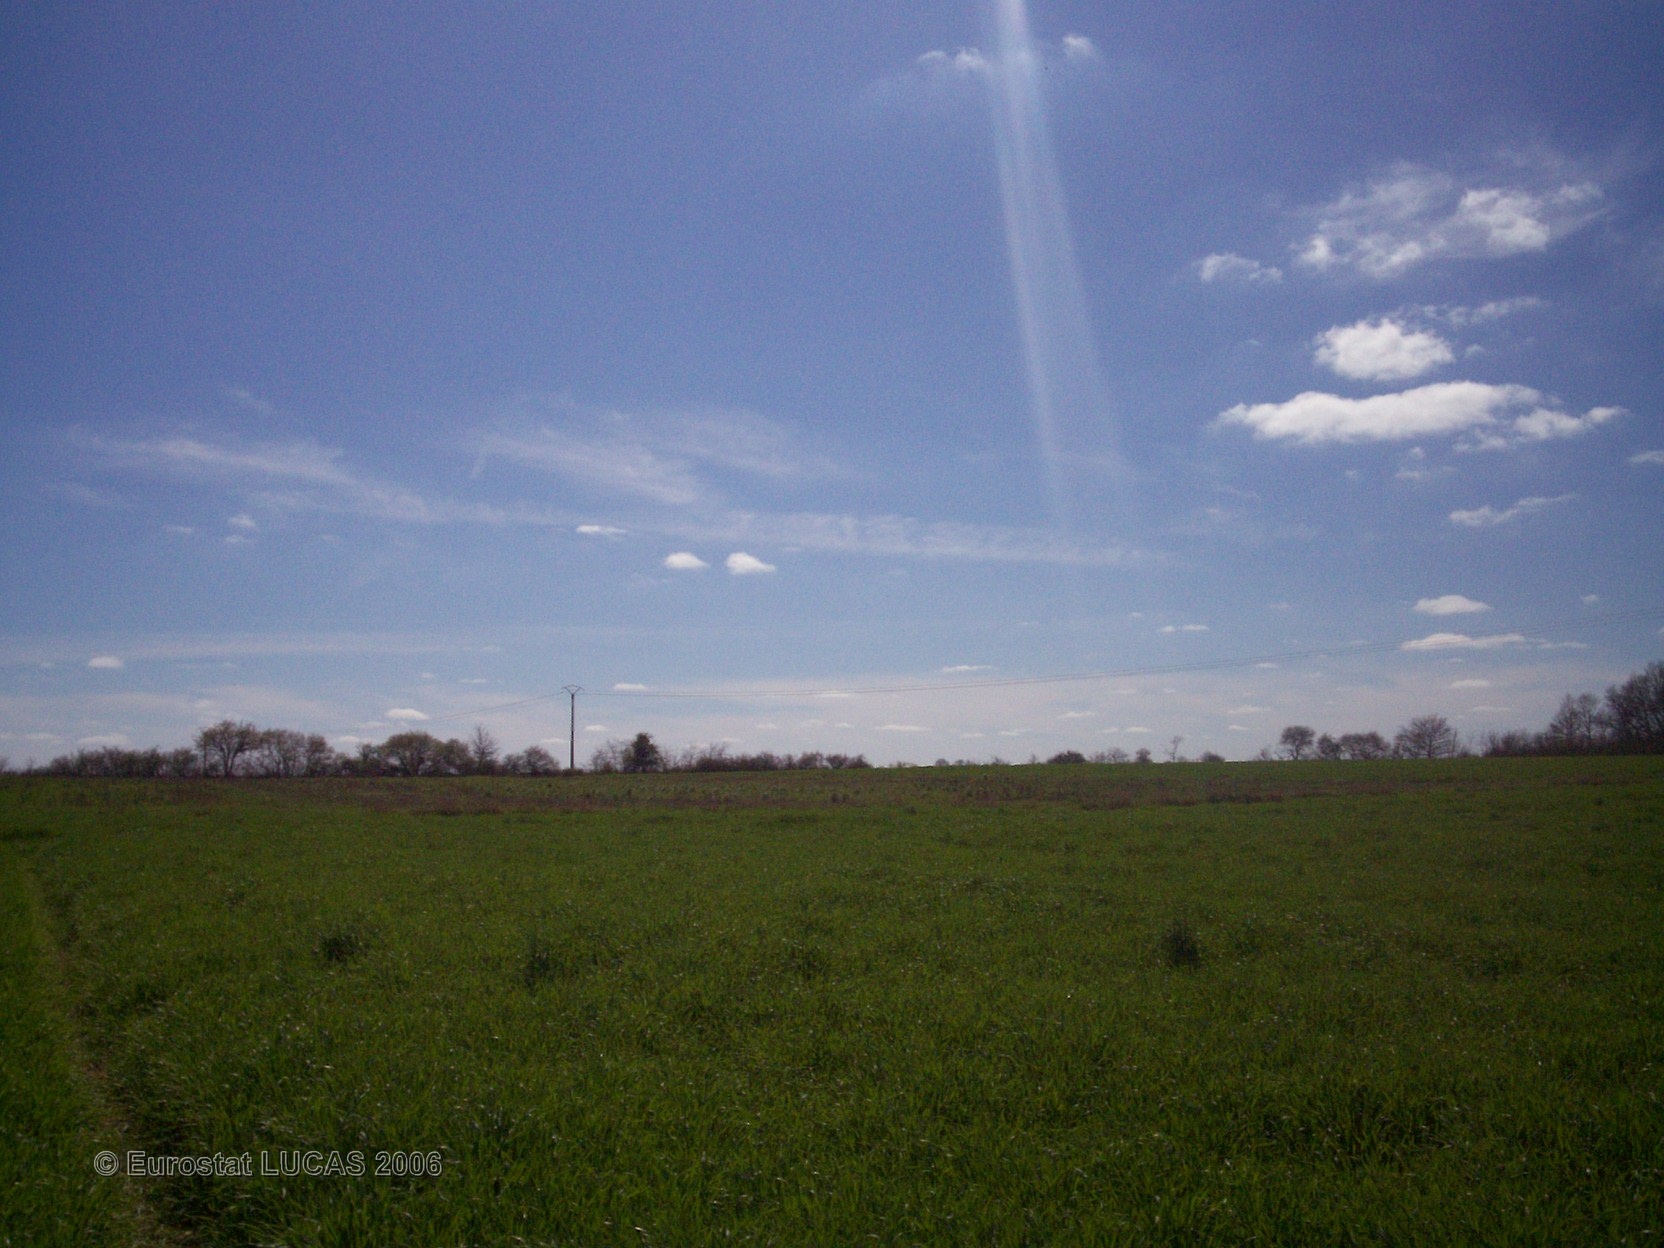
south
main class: Cropland
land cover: Barley
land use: Agriculture (excluding fallow land and kitchen gardens)
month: April
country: FR
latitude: 46.4347
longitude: 0.4951
